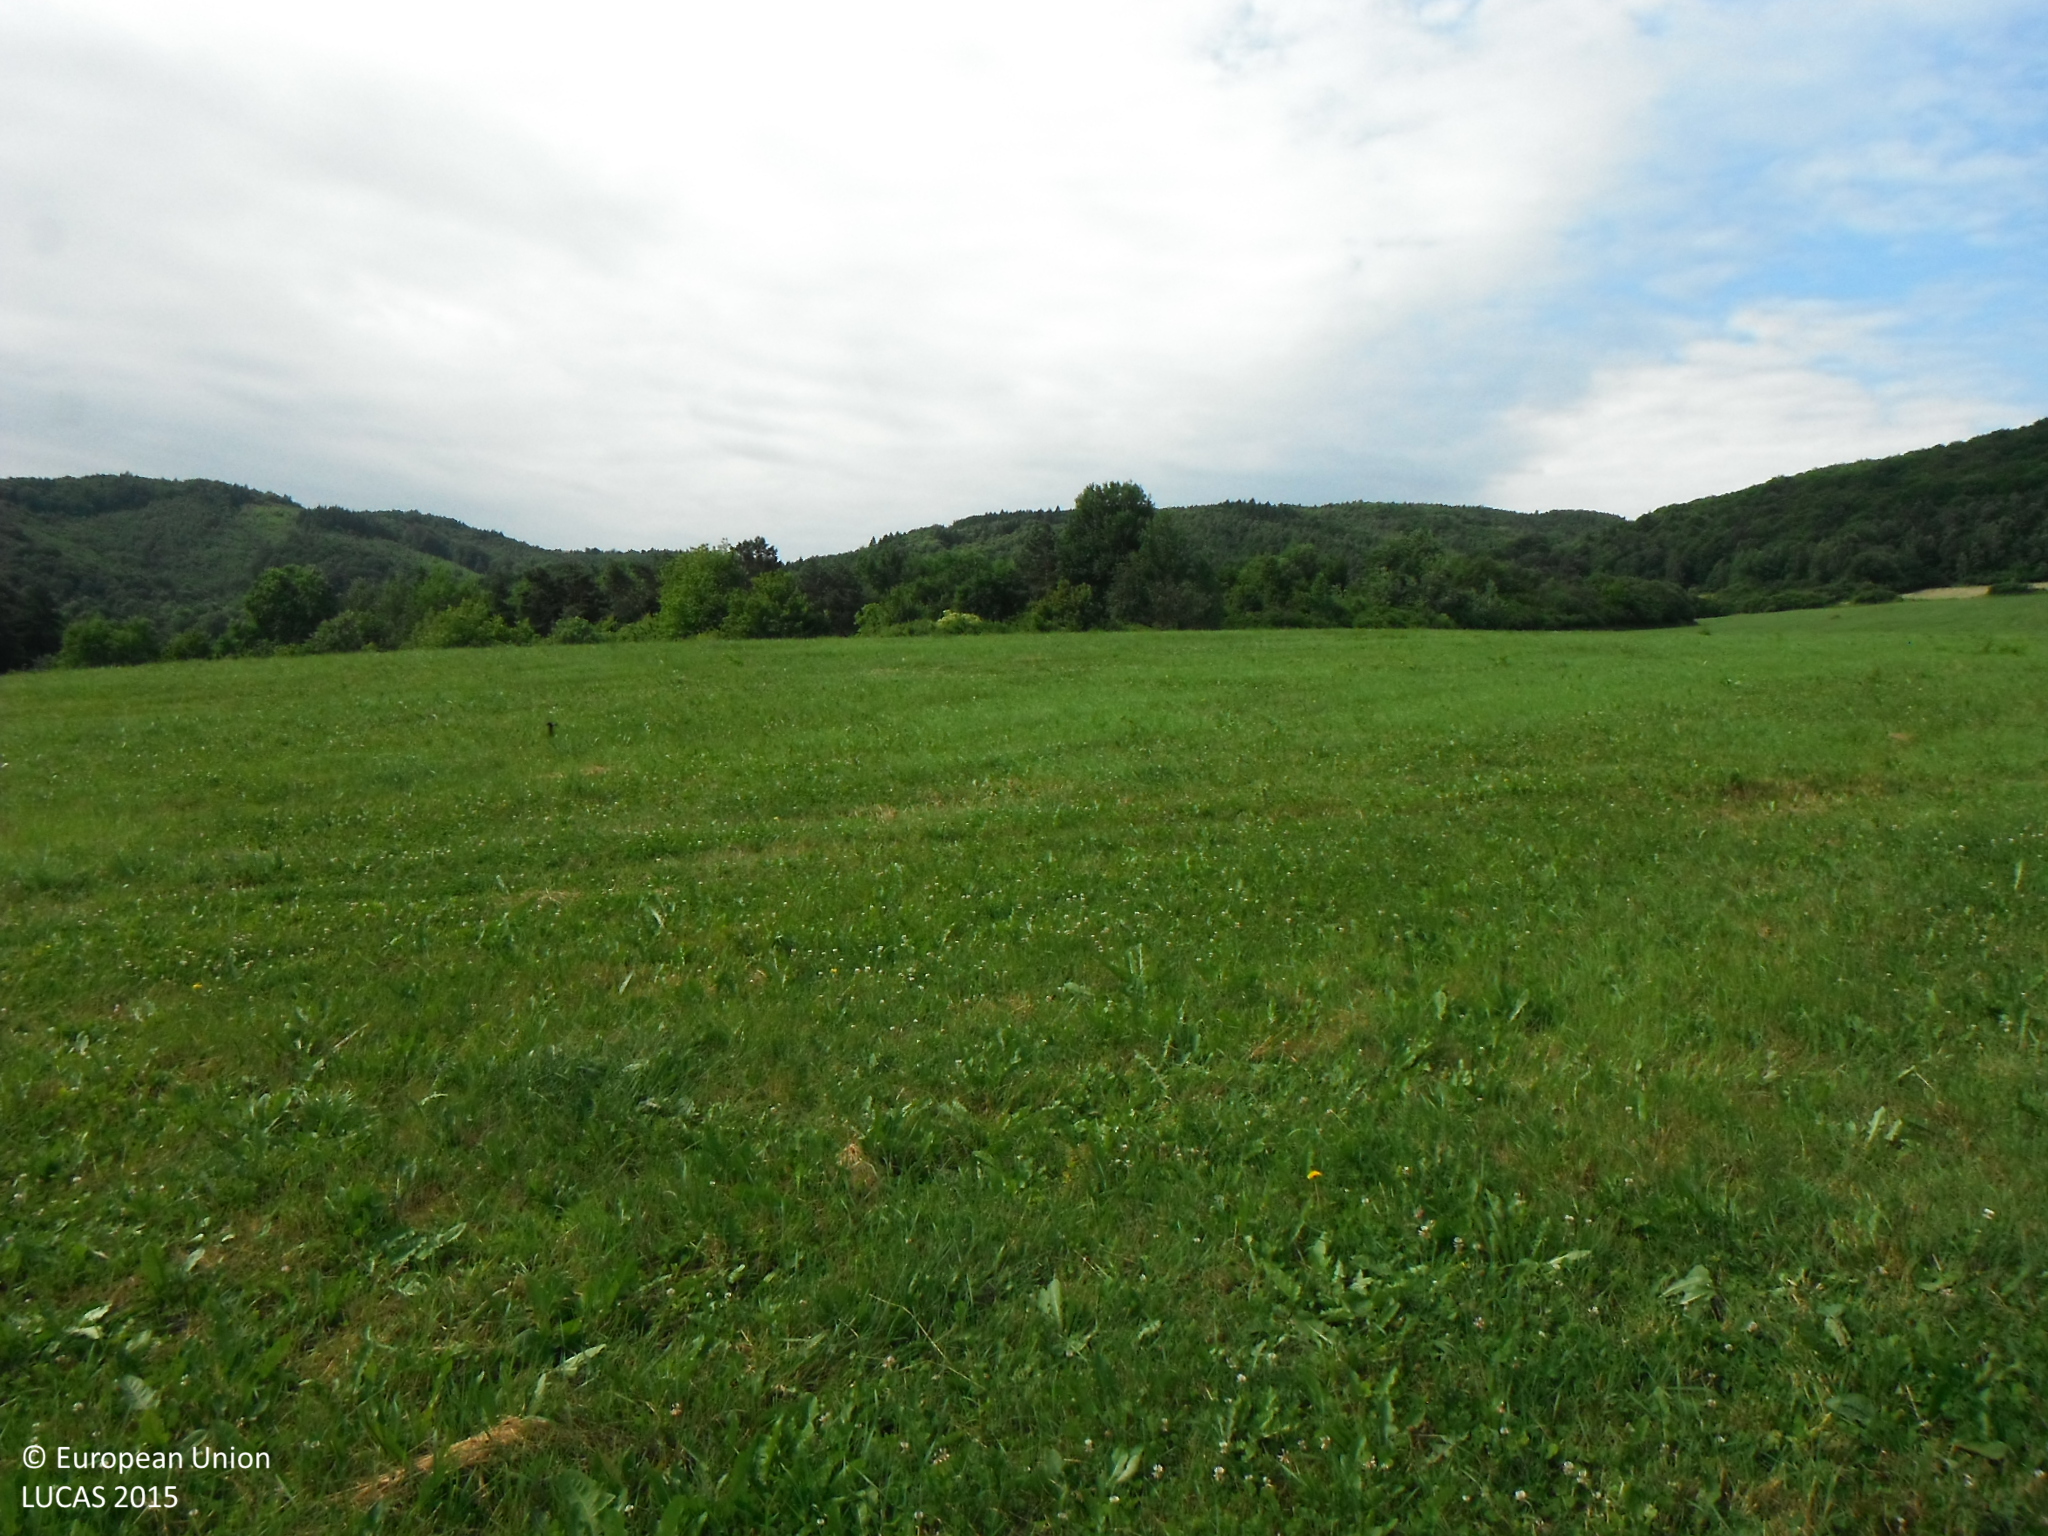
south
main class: Grassland
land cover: Grassland without tree/shrub cover
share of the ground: > 75 %
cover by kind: herbaceous plants 100 %
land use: Agriculture (excluding fallow land and kitchen gardens)
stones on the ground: < 10 %
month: June
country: SK
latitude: 49.1528
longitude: 21.6086
